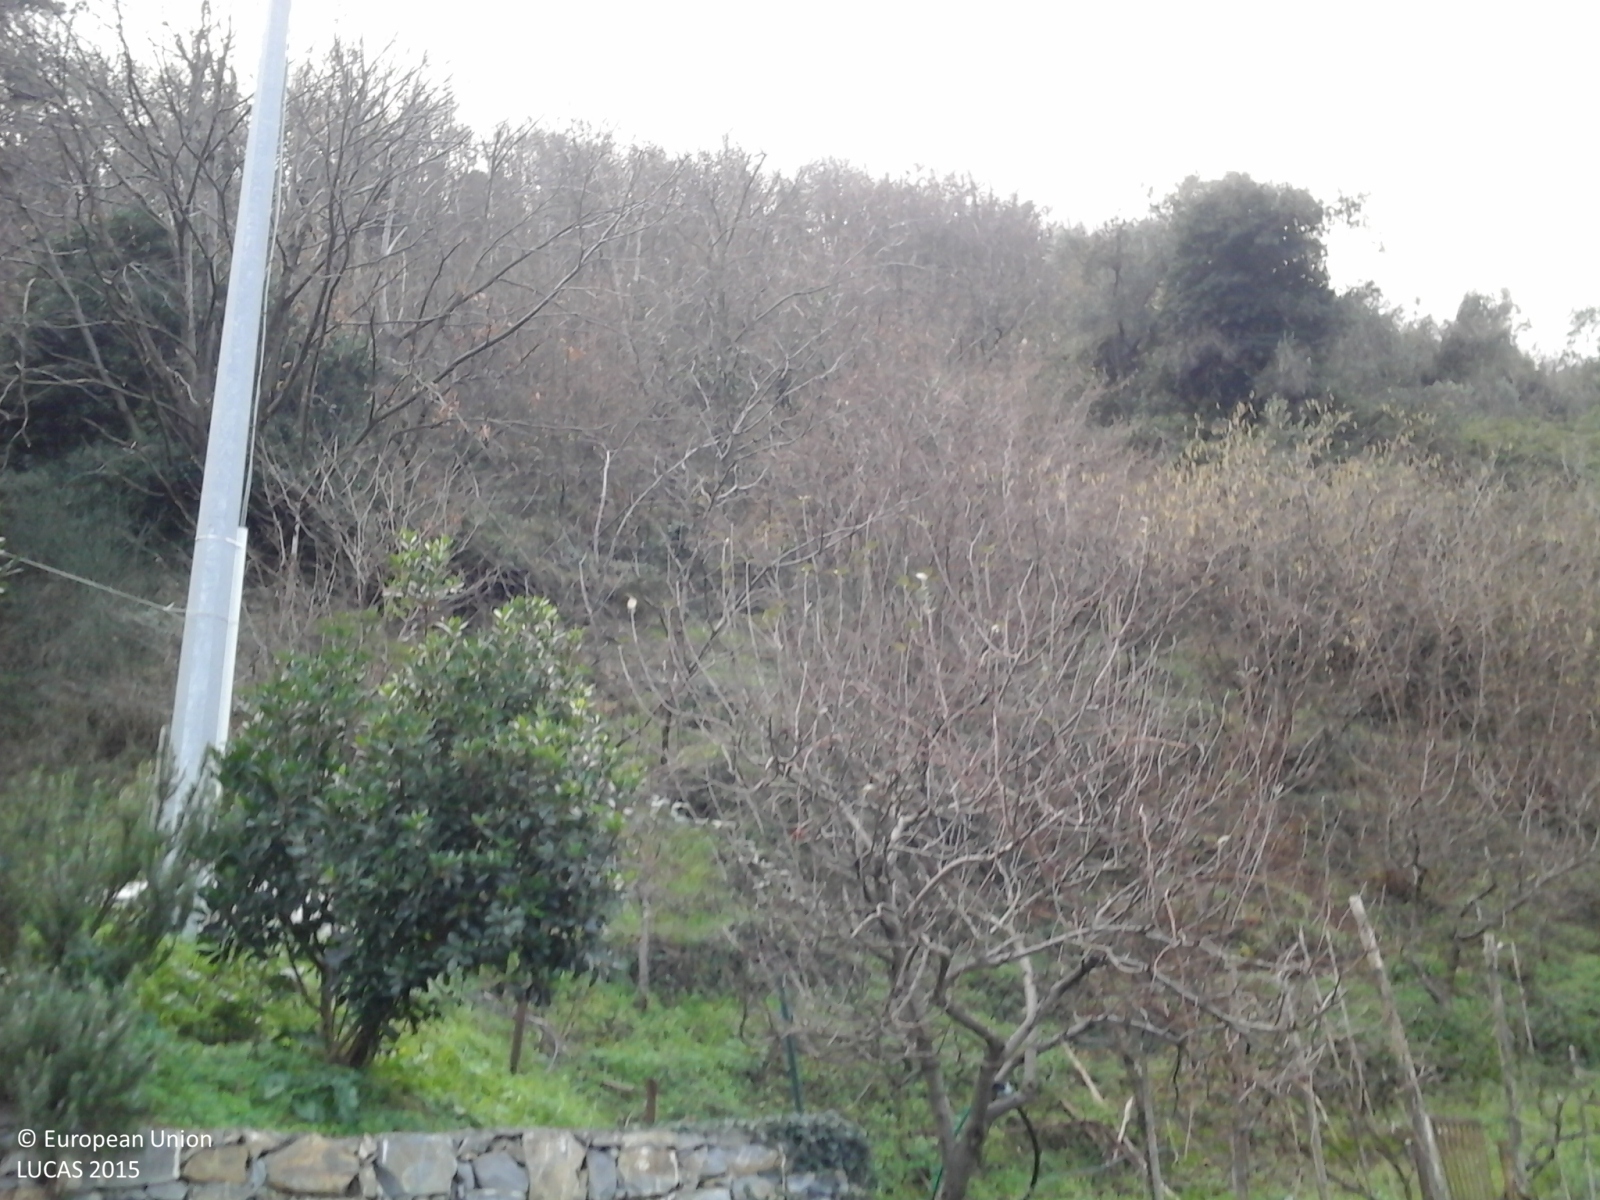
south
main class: Woodland
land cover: Broadleaved woodland
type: thermophilous deciduous forest
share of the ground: > 75 %
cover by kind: broadleaved forest trees 75 %, coniferous forest trees 10 %, shrubs 10 %, herbaceous plants 5 %
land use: Forestry
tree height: > 5 m
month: October
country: IT
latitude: 44.1875
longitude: 9.6131
